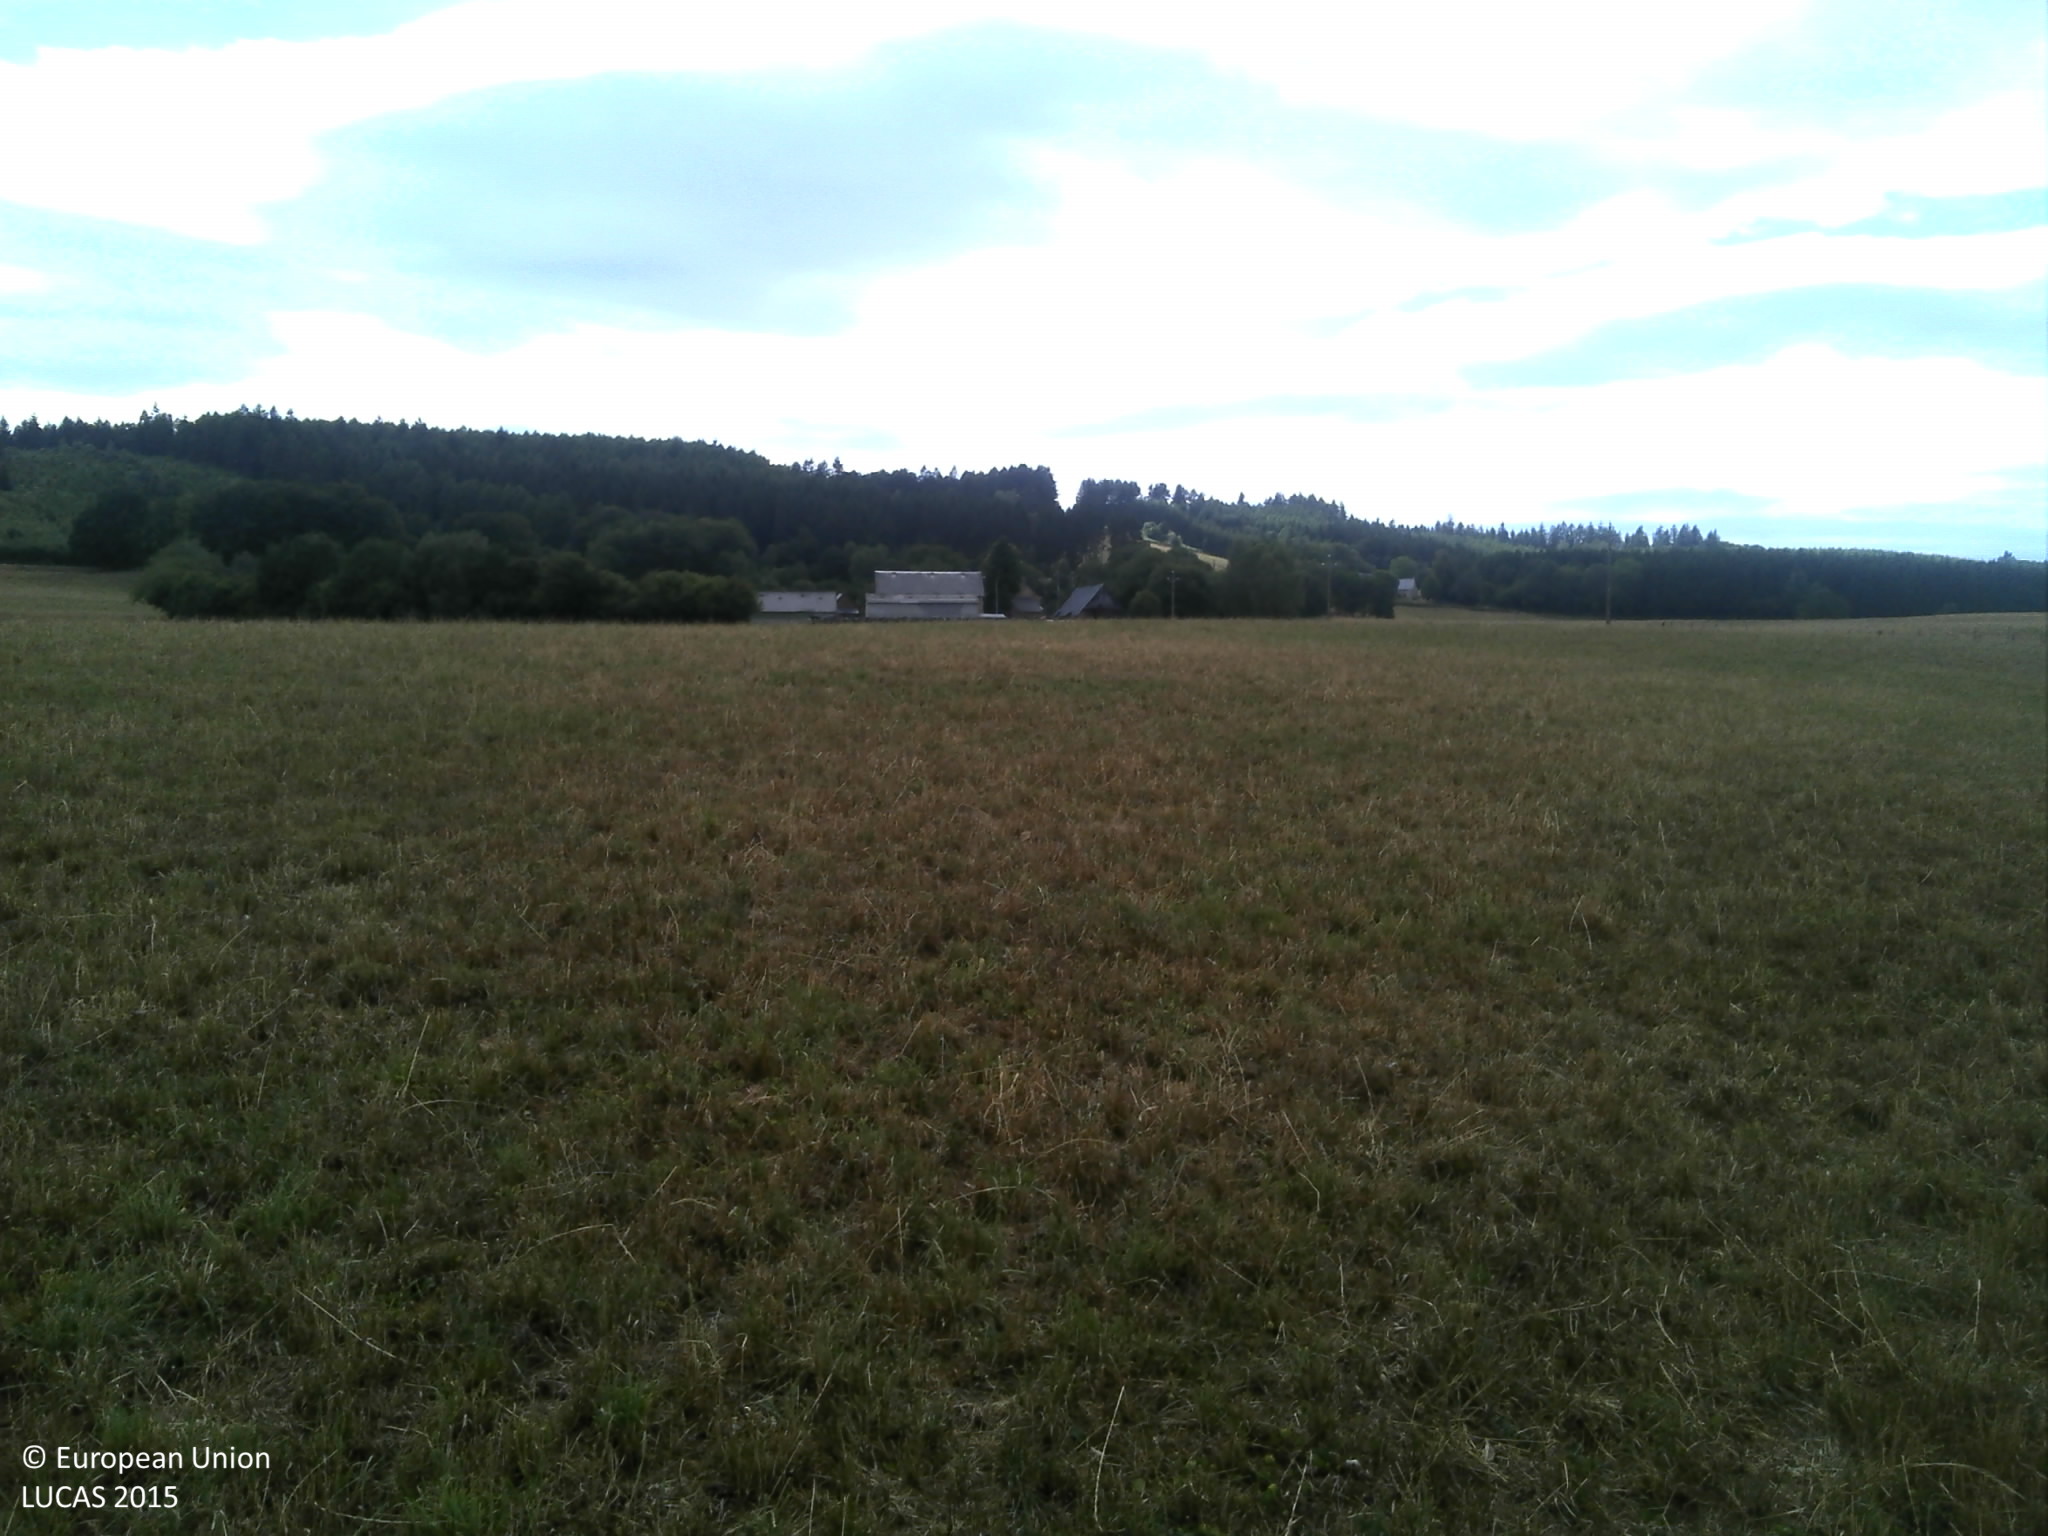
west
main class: Grassland
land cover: Grassland without tree/shrub cover
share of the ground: > 75 %
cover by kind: herbaceous plants 100 %
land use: Agriculture (excluding fallow land and kitchen gardens)
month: July
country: FR
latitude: 45.6277
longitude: 2.3914
